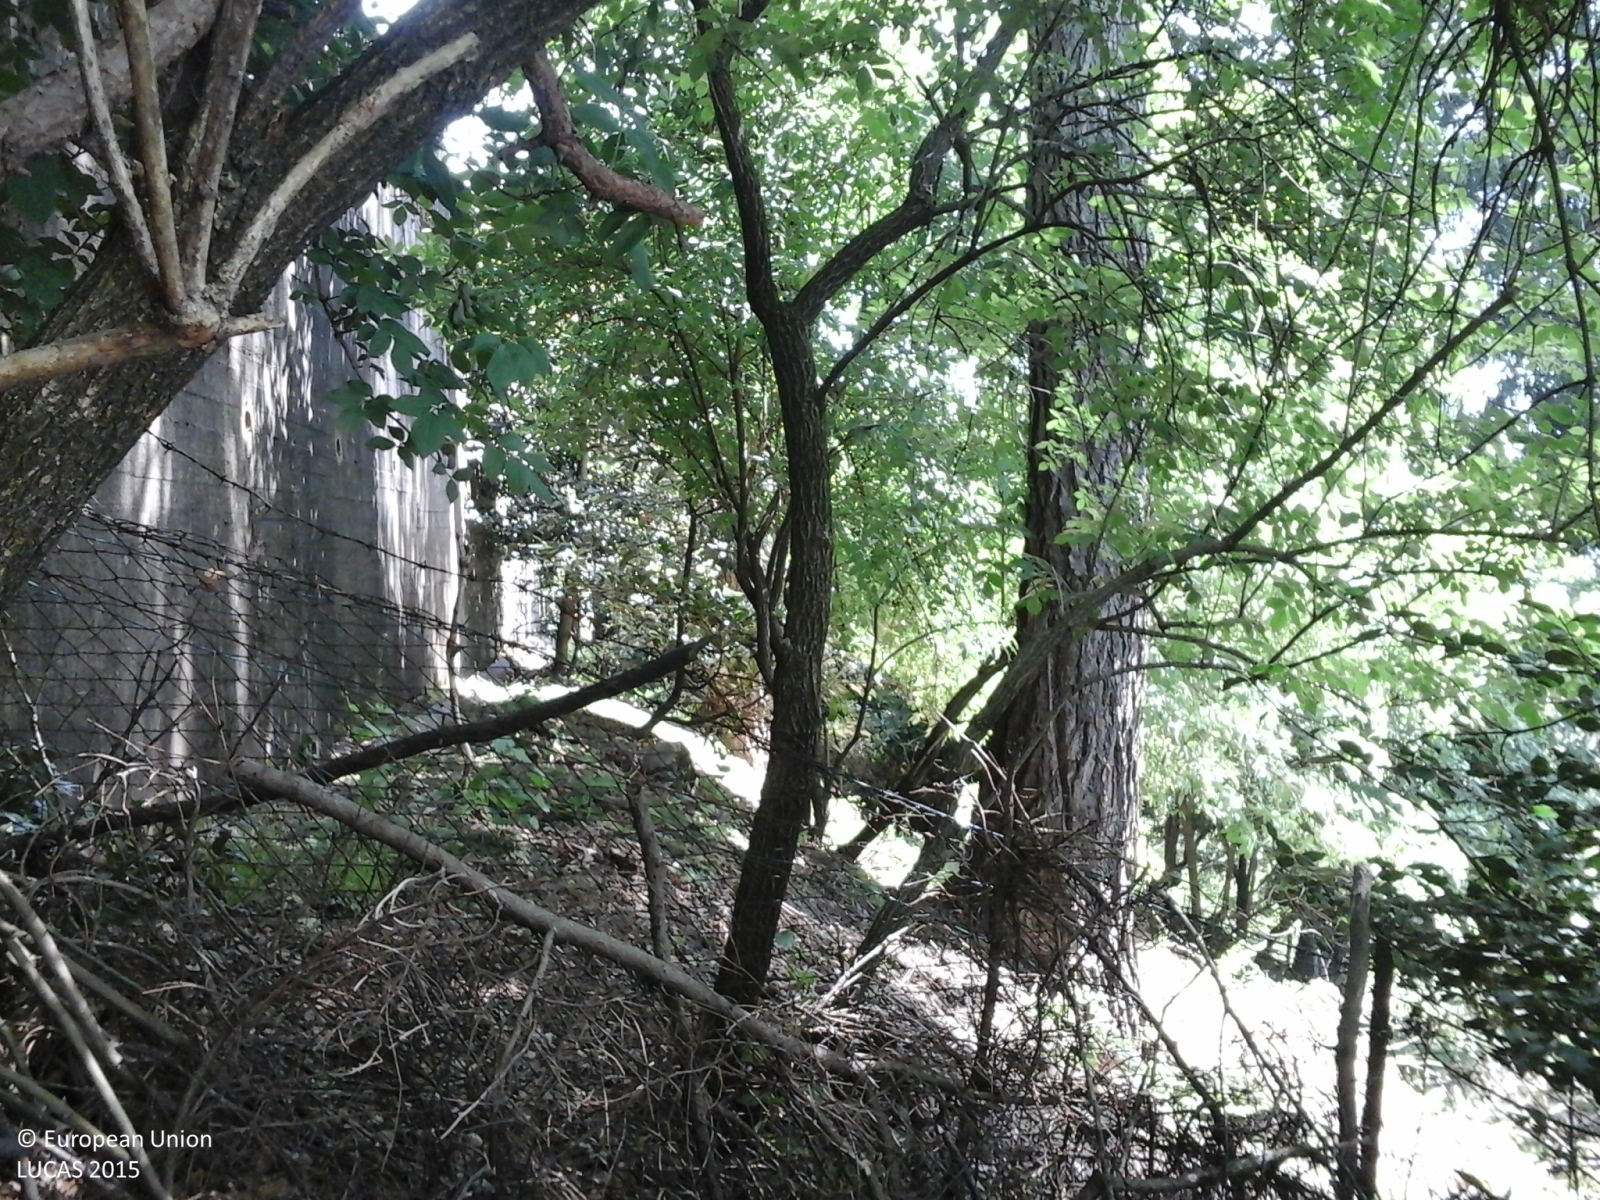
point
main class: Woodland
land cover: Other mixed woodland
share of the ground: > 75 %
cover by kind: coniferous forest trees 50 %, broadleaved forest trees 30 %, shrubs 10 %, unconsolidated bare surface 10 %
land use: Forestry
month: May
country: IT
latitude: 45.8250
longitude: 9.1132
